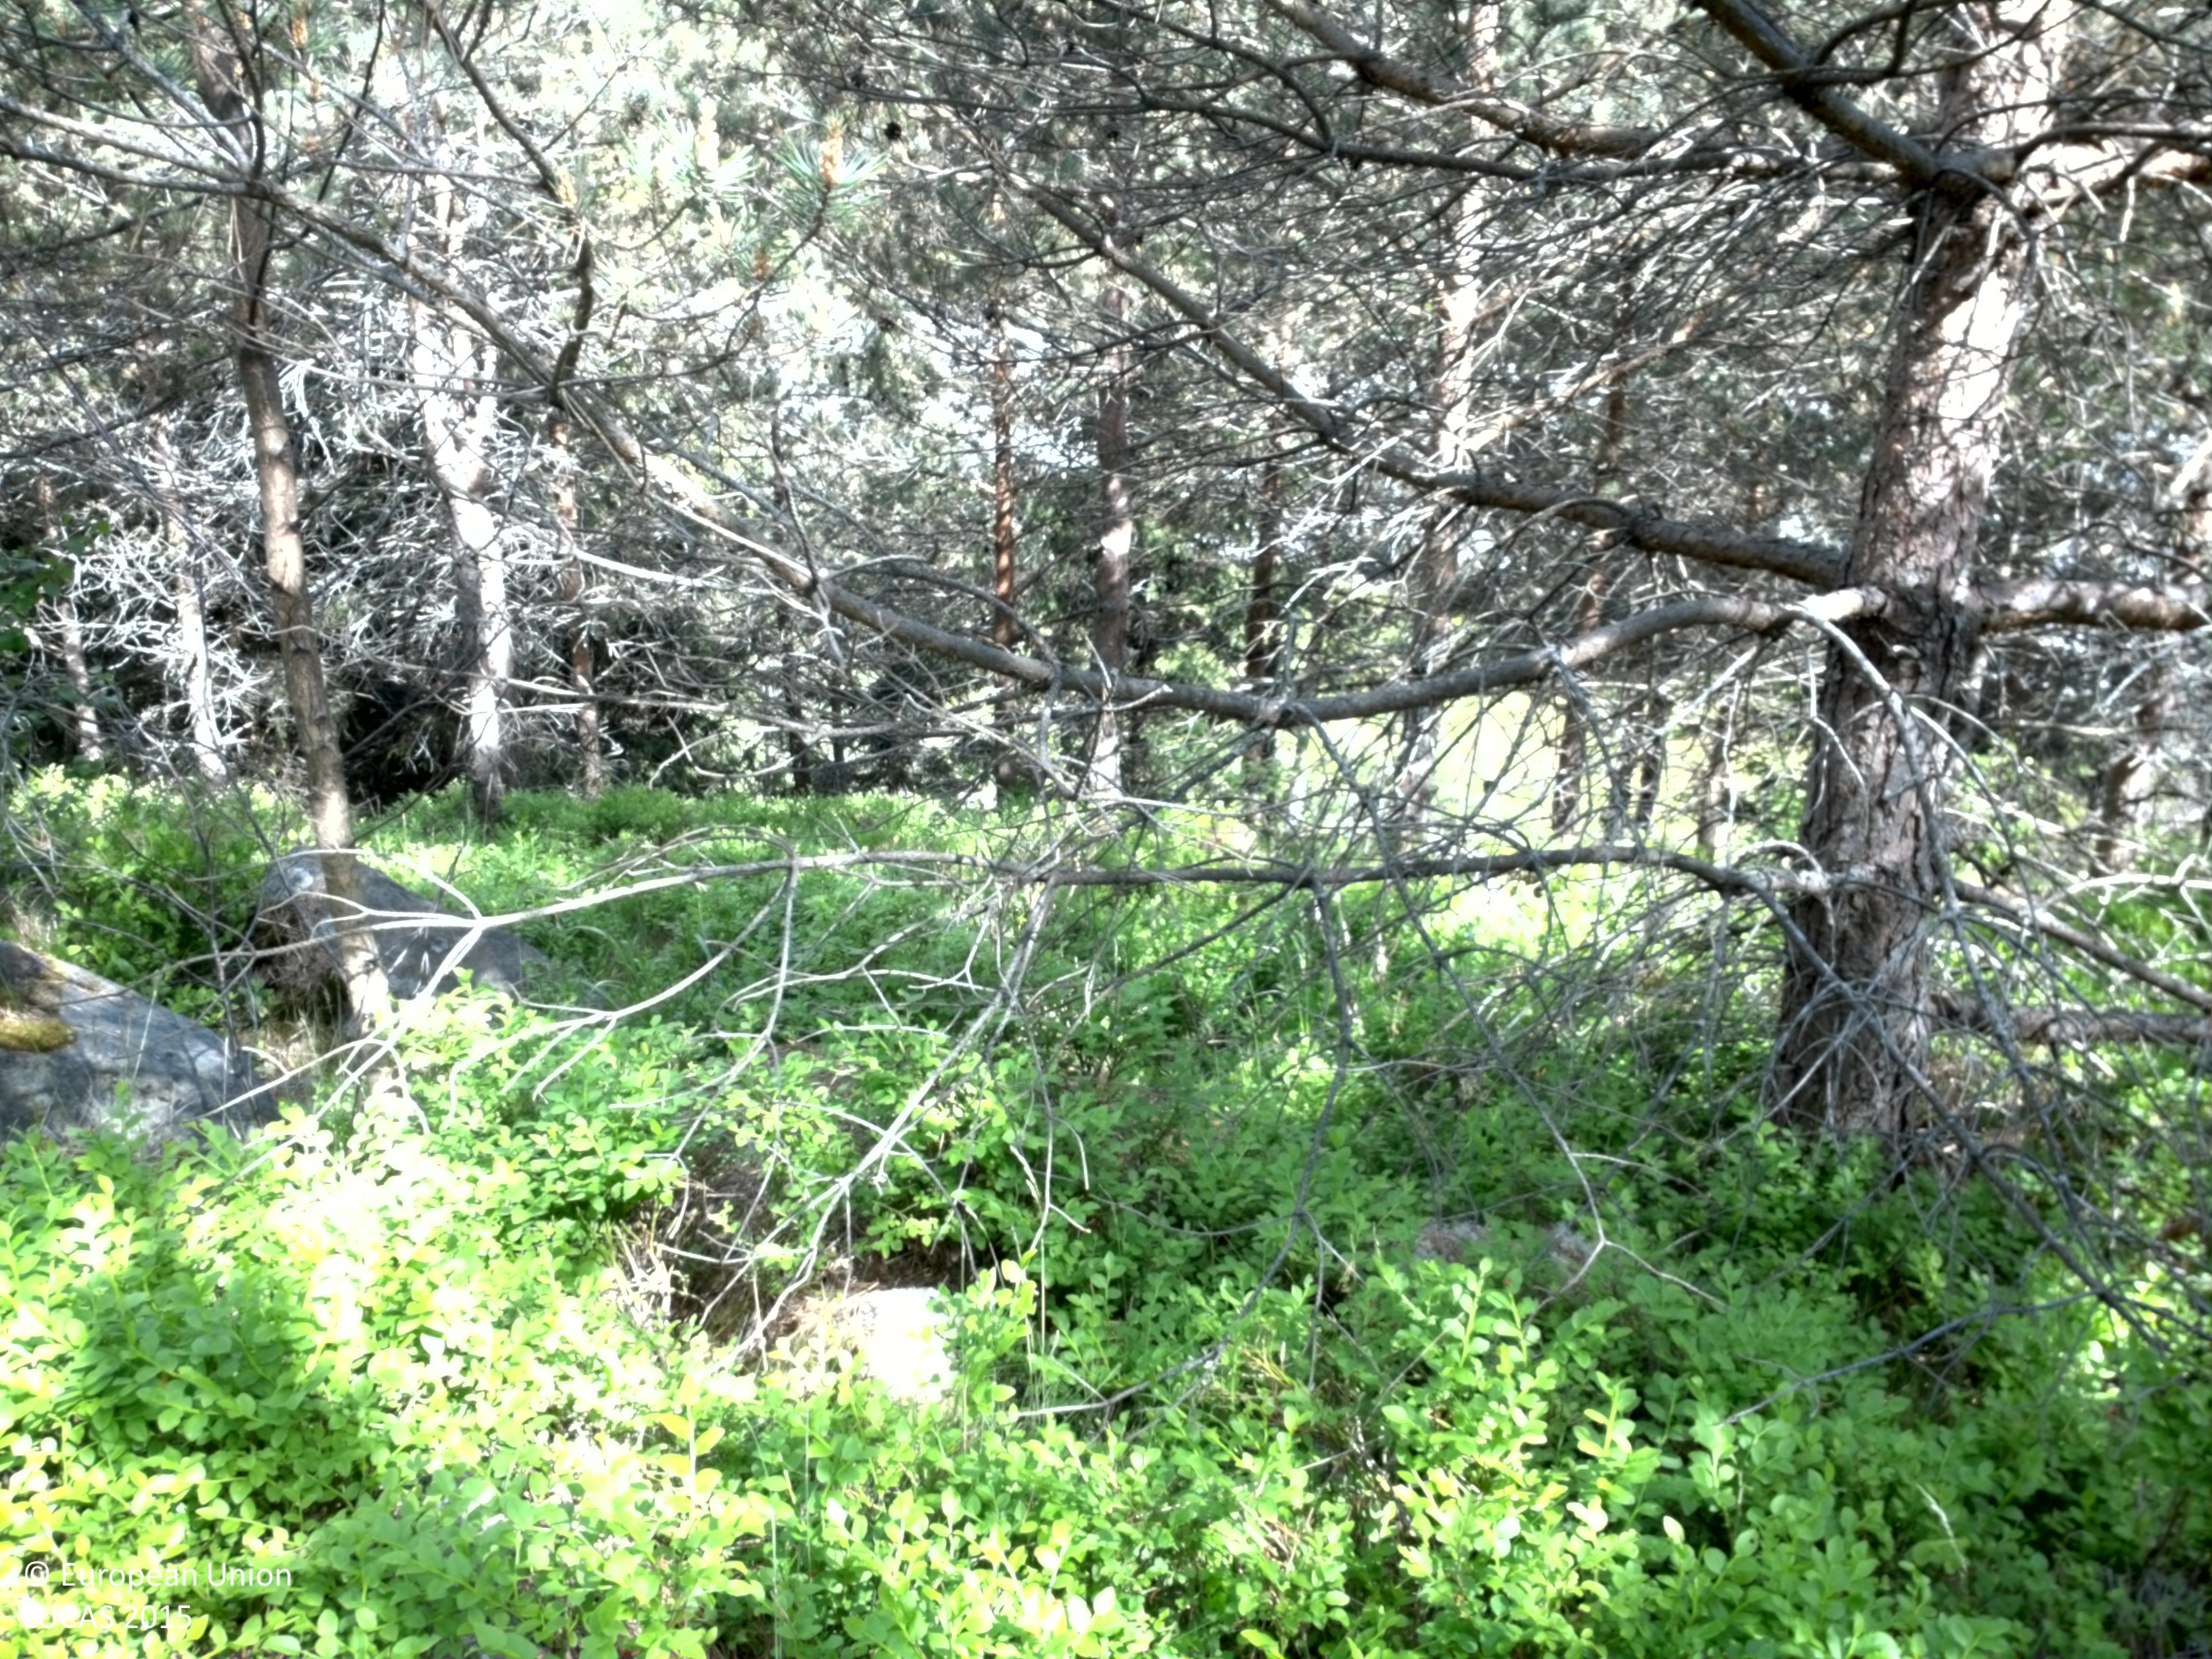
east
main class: Woodland
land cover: Pine dominated coniferous woodland
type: boreal forest
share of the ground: 10 - 25 %
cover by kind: shrubs 50 %, coniferous forest trees 20 %, lichens and mosses 20 %, broadleaved forest trees 5 %, herbaceous plants 5 %
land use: Forestry
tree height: < 5 m
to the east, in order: Pine dominated coniferous woodland; Spontaneously vegetated surfaces; Fences; Spontaneously vegetated surfaces; Paved roads, cycling and walking lanes; Spontaneously vegetated surfaces; Fences; Spontaneously vegetated surfaces; Pine dominated mixed woodland
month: June
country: SE
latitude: 58.6843
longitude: 16.3257
